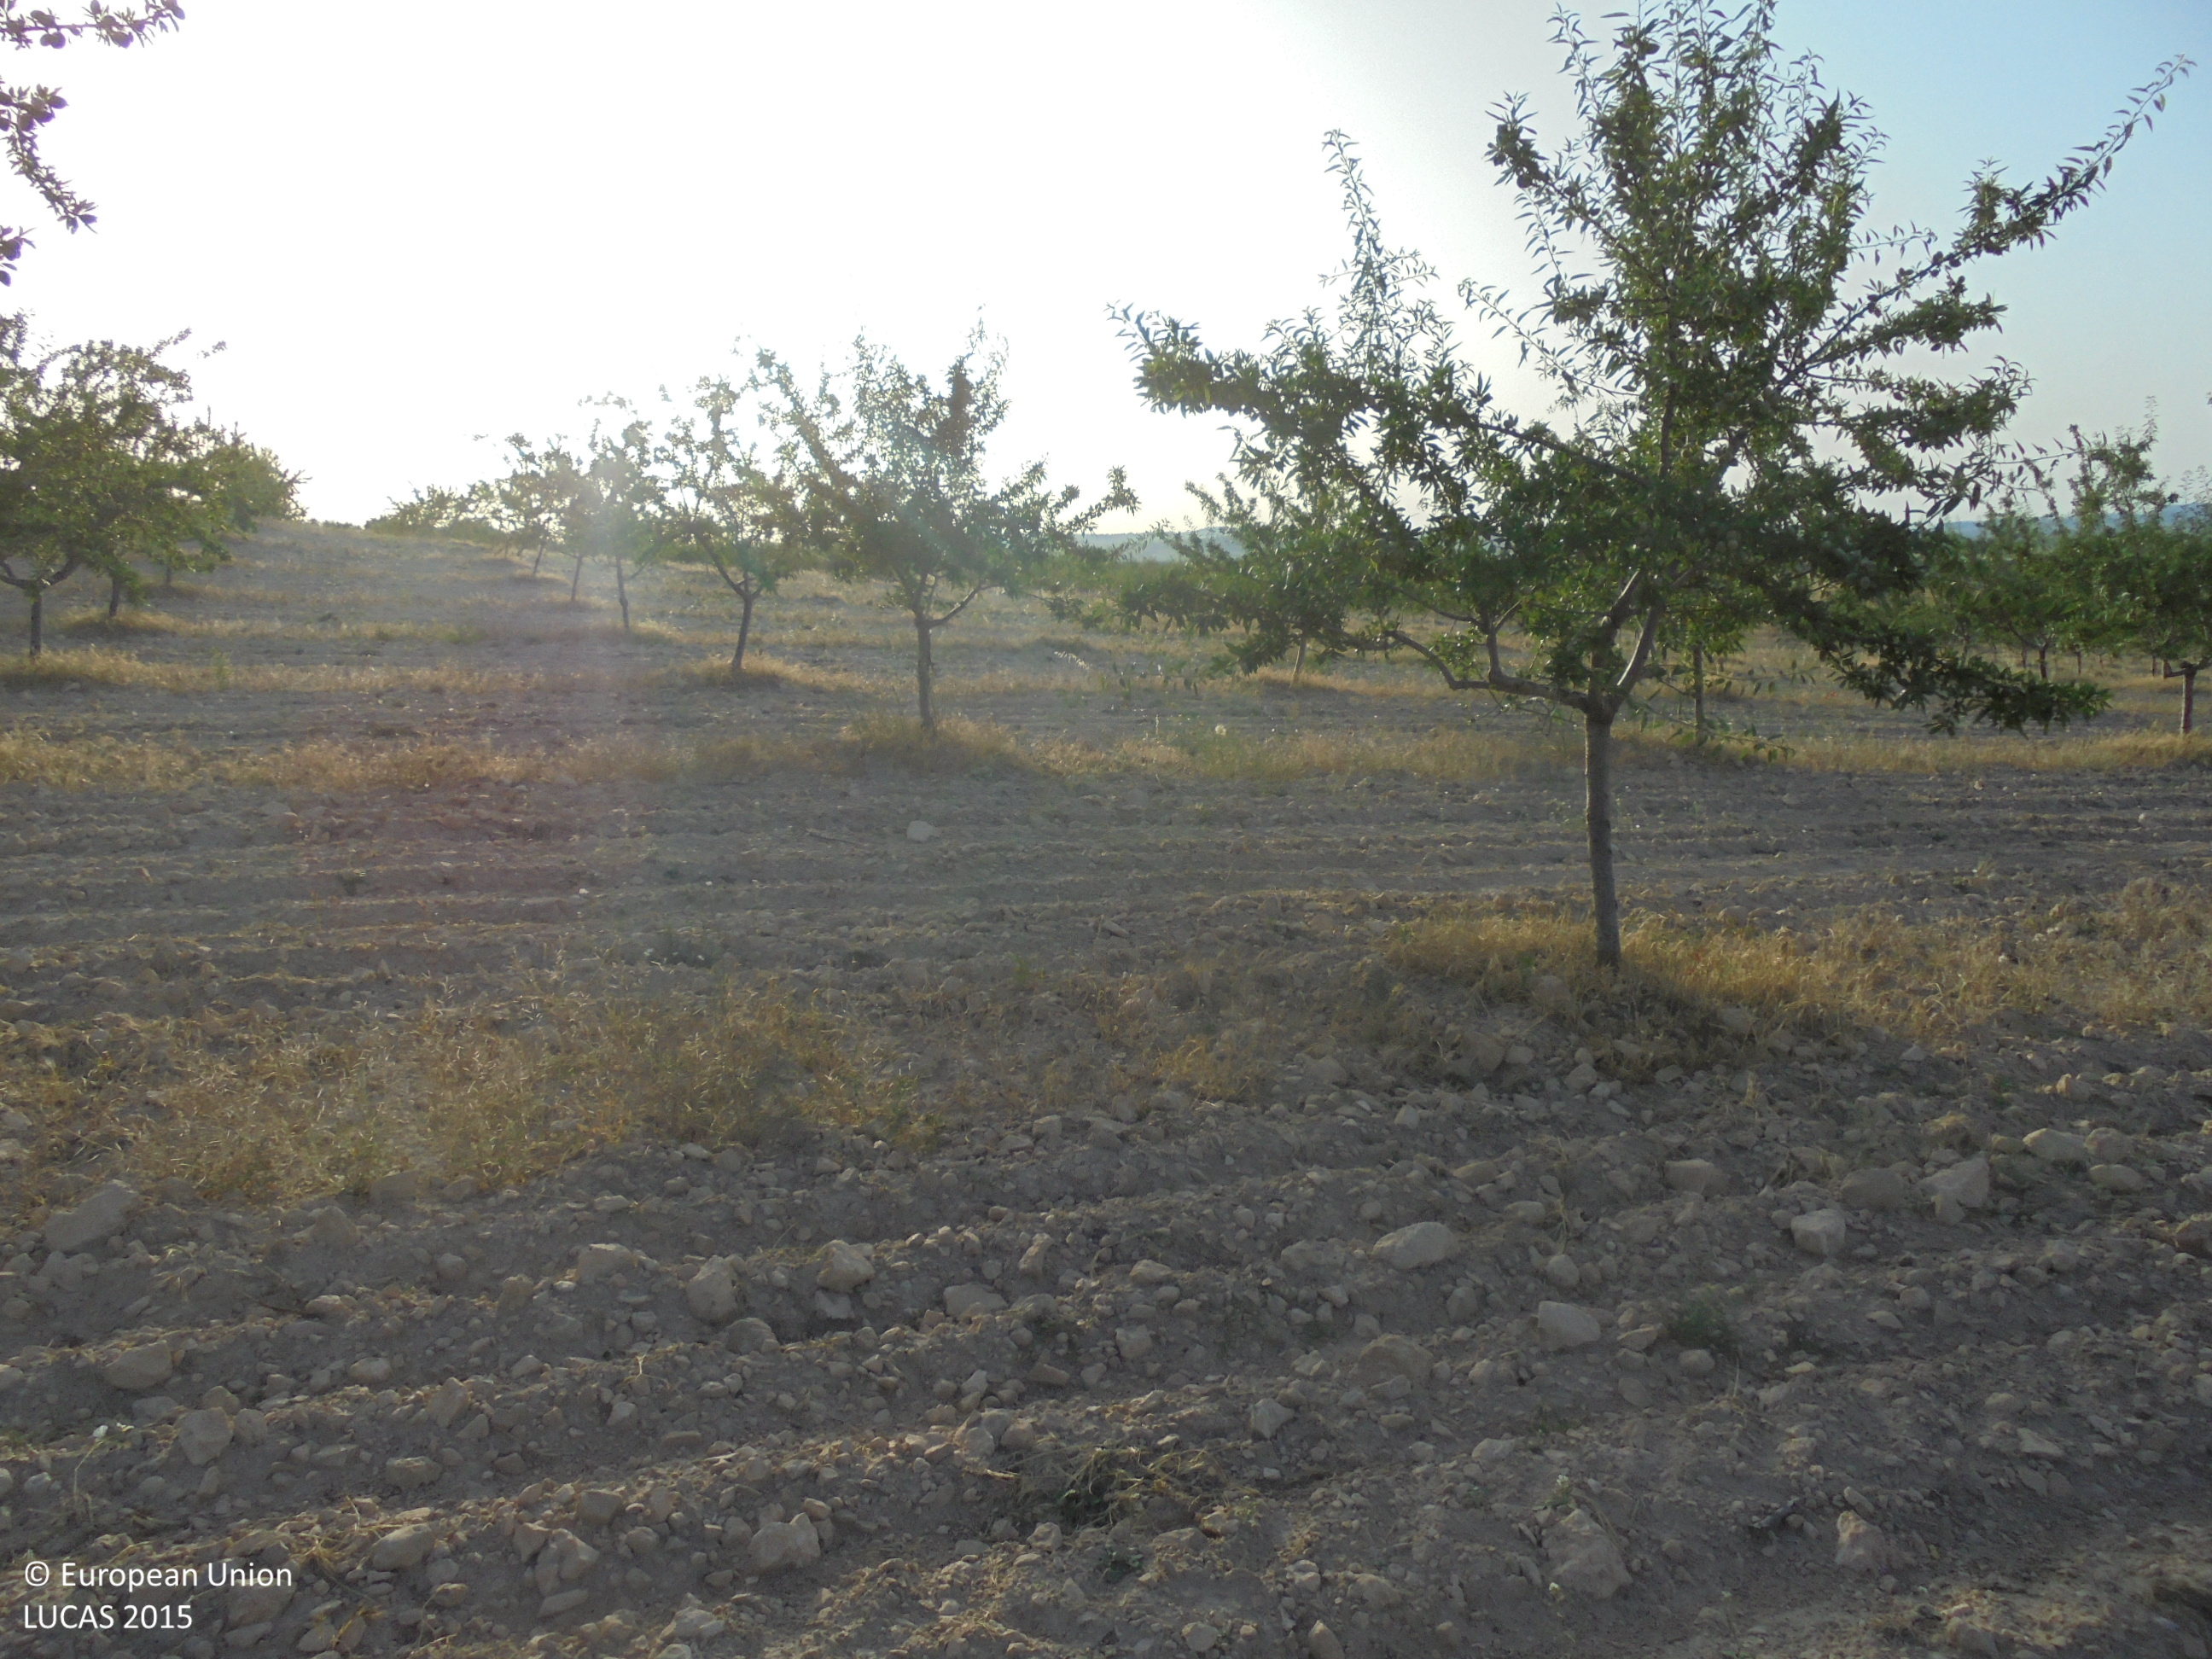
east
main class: Cropland
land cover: Nuts trees
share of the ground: 10 - 25 %
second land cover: Spontaneously vegetated surfaces
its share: 25 - 50 %
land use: Agriculture (excluding fallow land and kitchen gardens)
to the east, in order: Nuts trees; Spontaneously vegetated surfaces
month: July
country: ES
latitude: 38.7221
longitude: -1.7165
